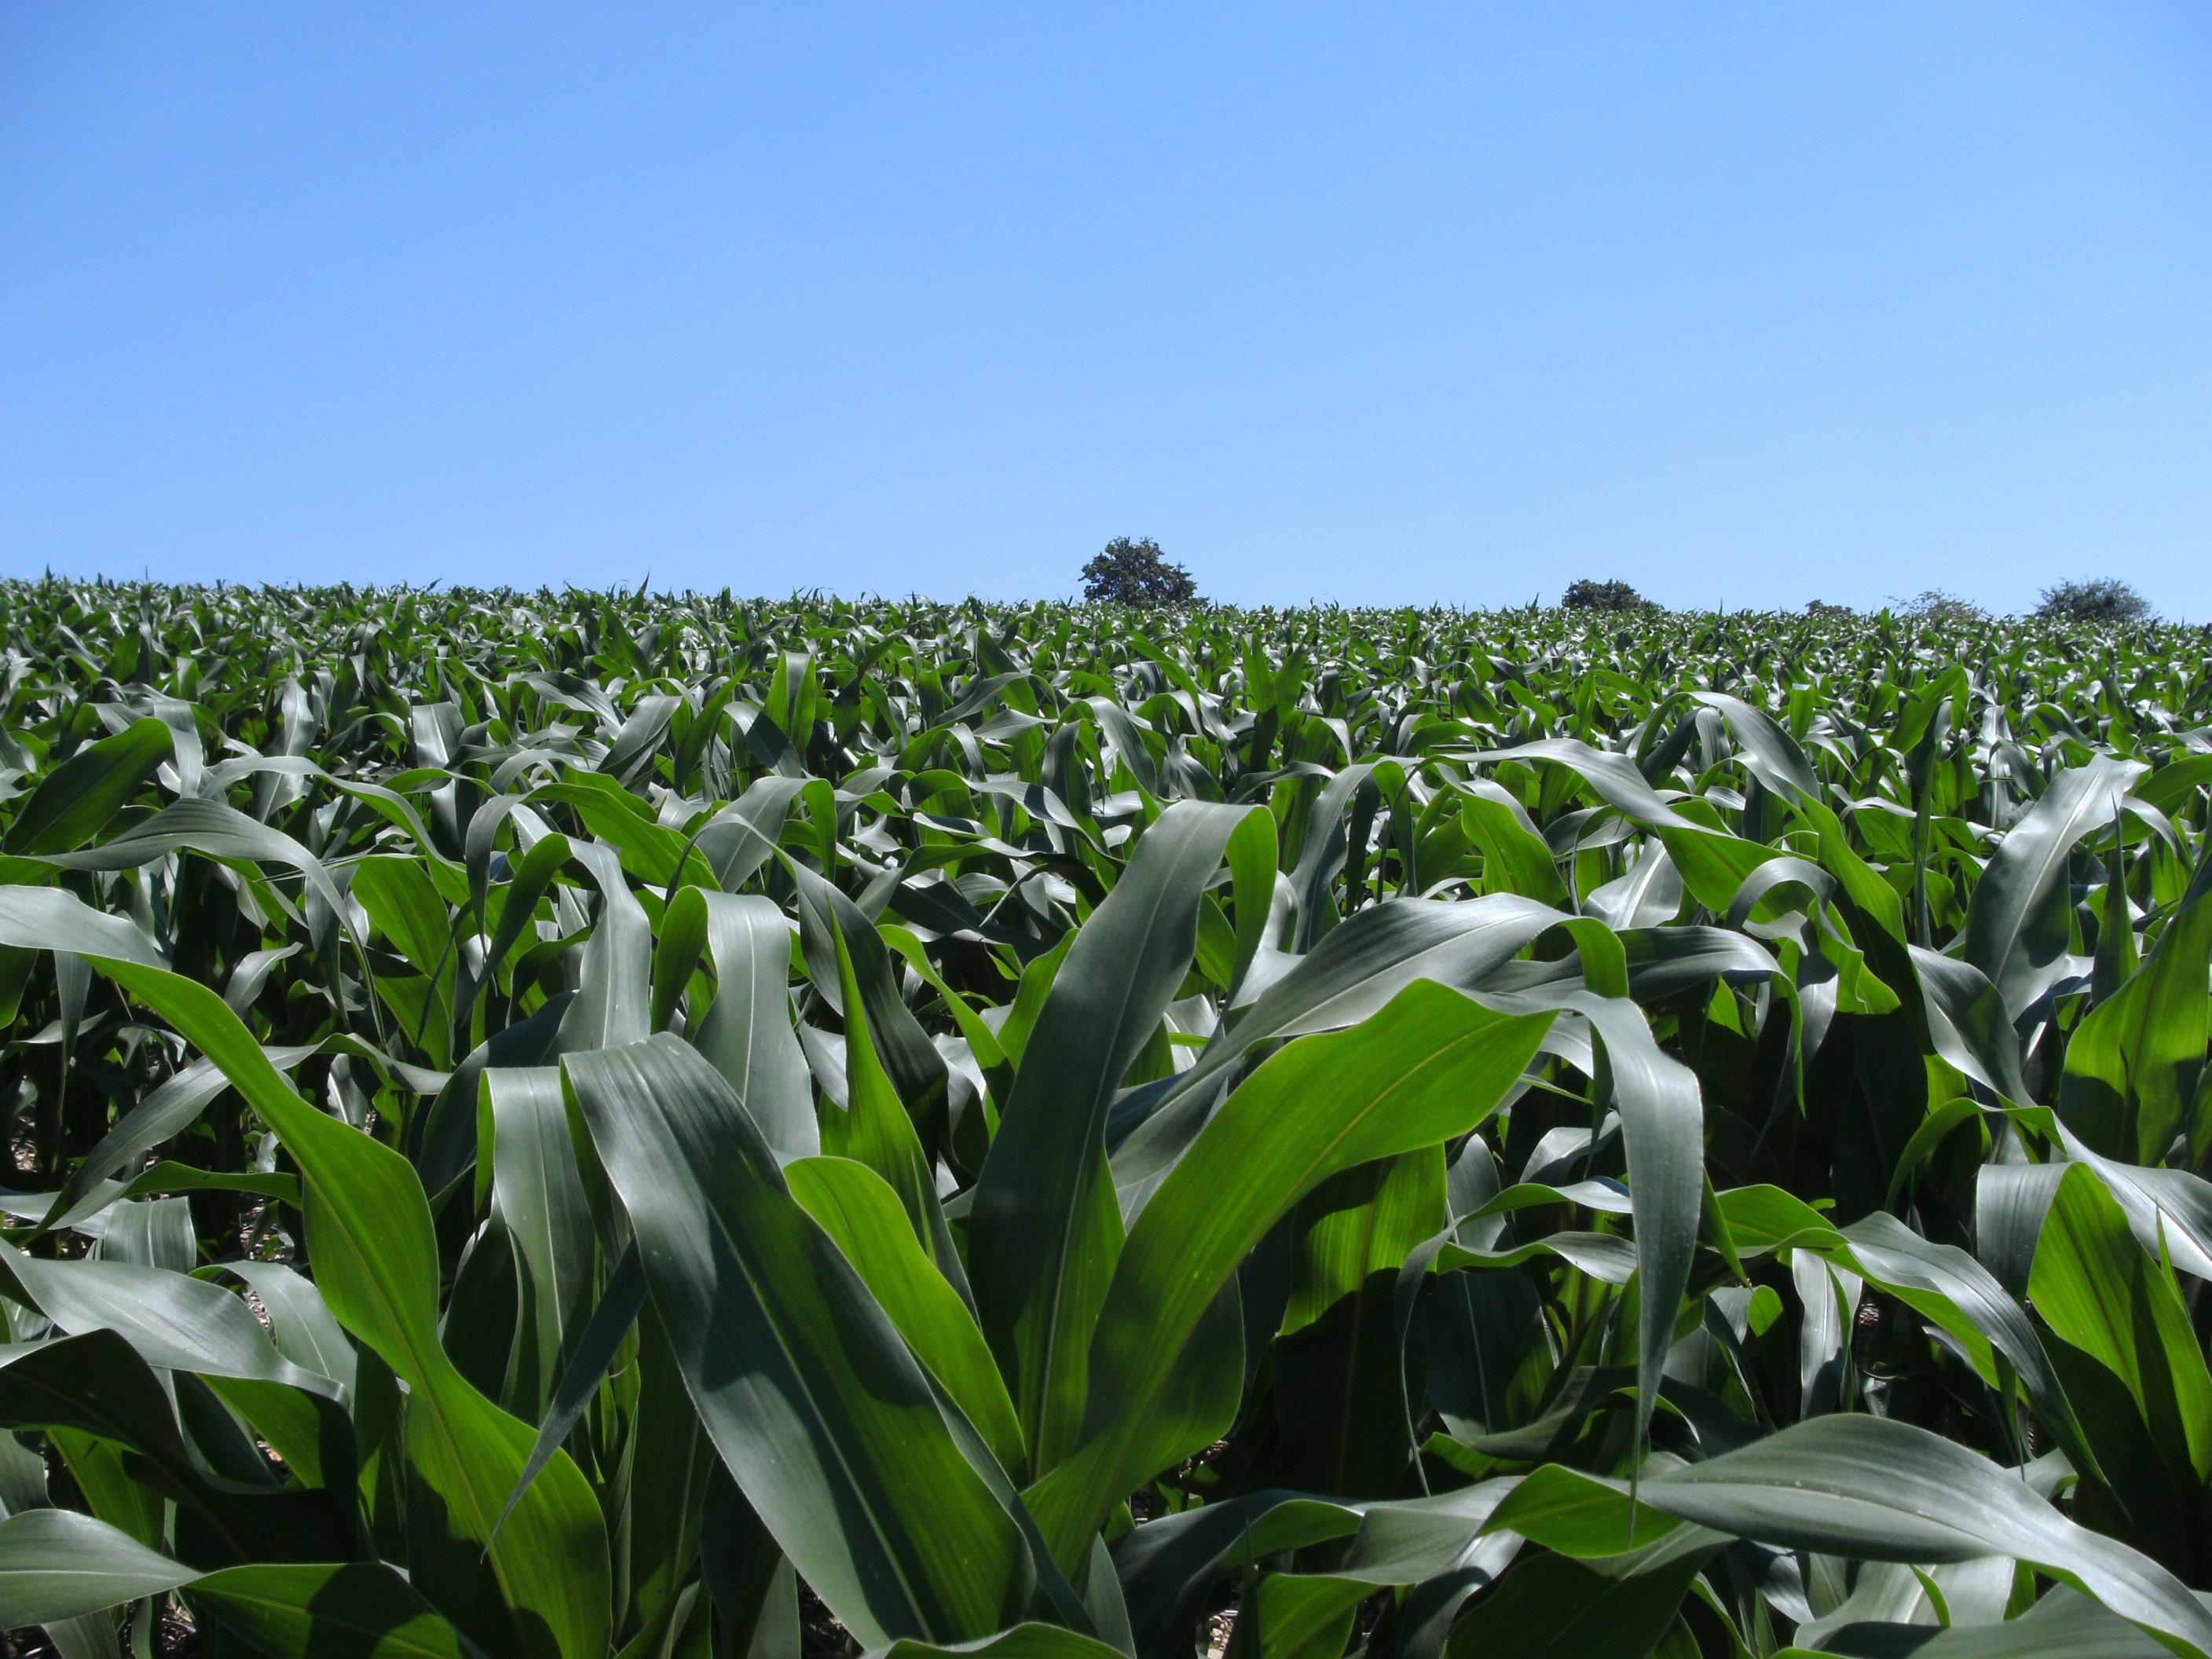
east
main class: Cropland
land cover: Maize
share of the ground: > 75 %
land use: Agriculture (excluding fallow land and kitchen gardens)
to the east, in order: Maize; Grassland without tree/shrub cover; Triticale; Pear fruit; Tracks; Single bushes/trees; Grassland without tree/shrub cover; Artificial constructions in urban areas; Grassland without tree/shrub cover
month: July
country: AT
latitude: 48.2079
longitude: 13.3768
